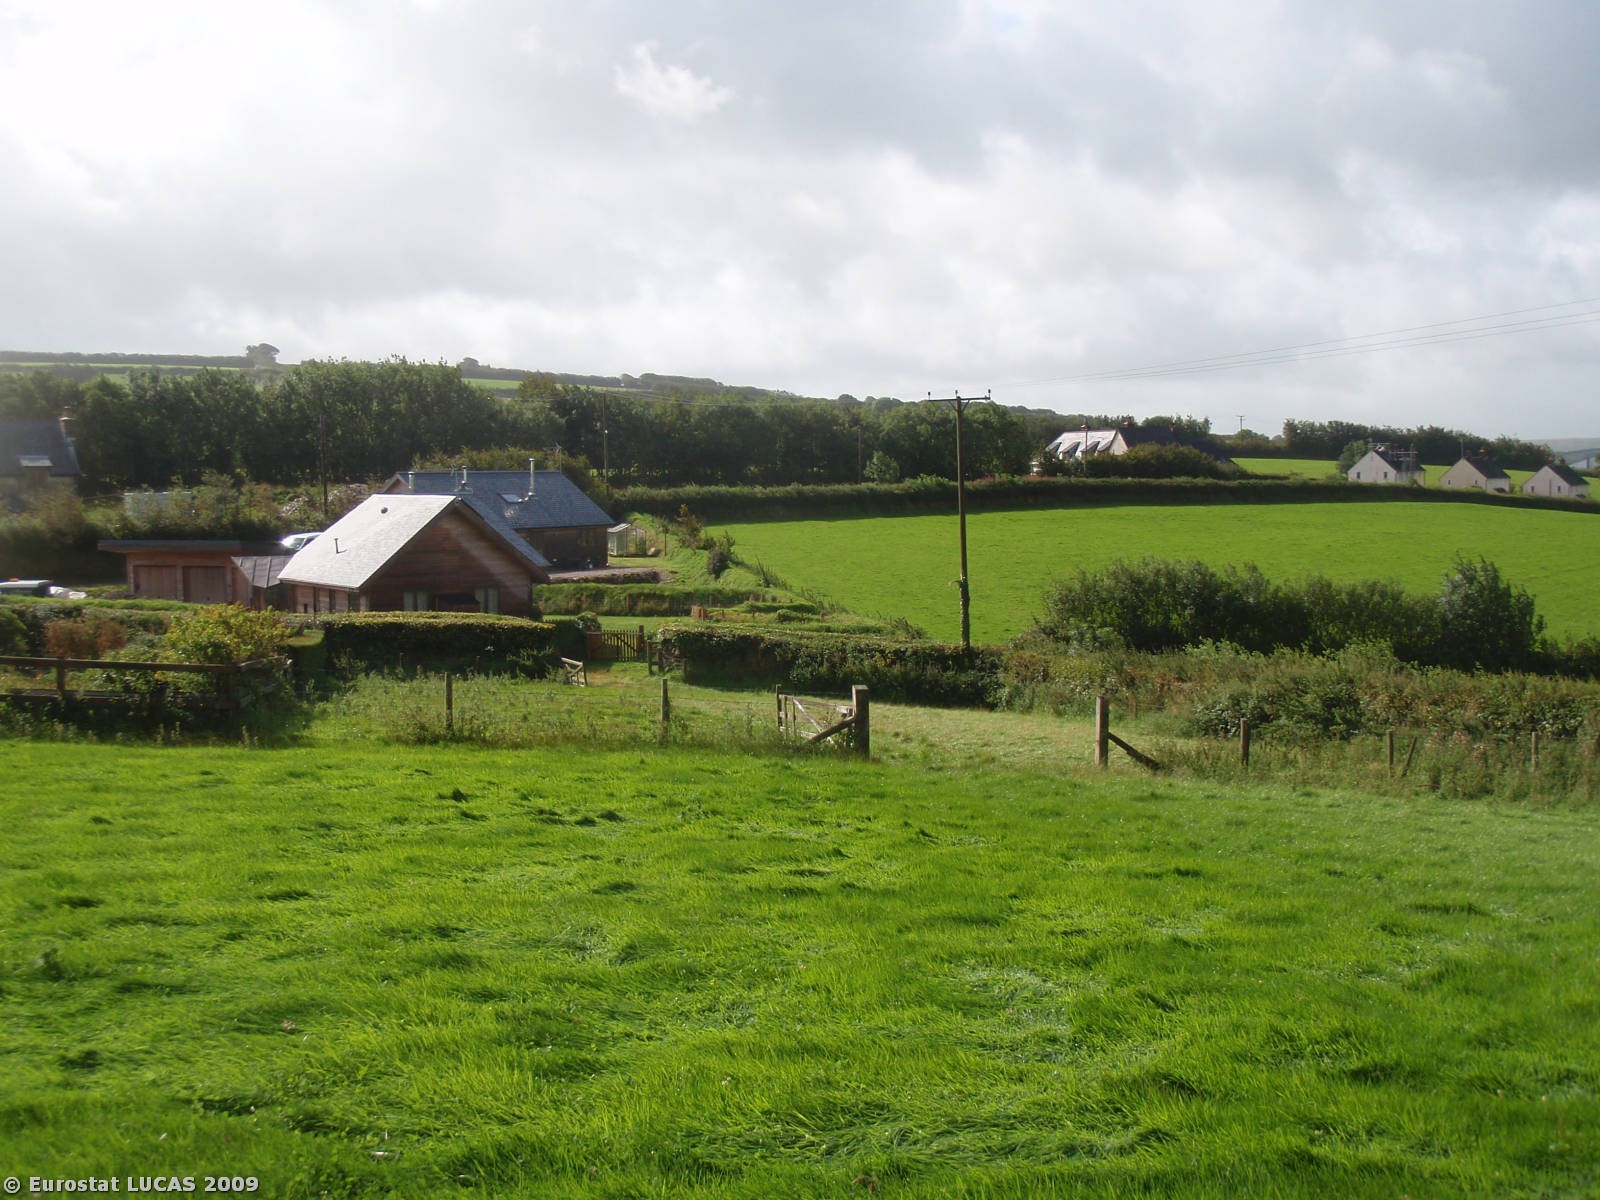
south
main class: Grassland
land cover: Grassland without tree/shrub cover
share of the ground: > 75 %
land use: Agriculture (excluding fallow land and kitchen gardens)
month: August
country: GB
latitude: 51.1415
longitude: -3.5350
